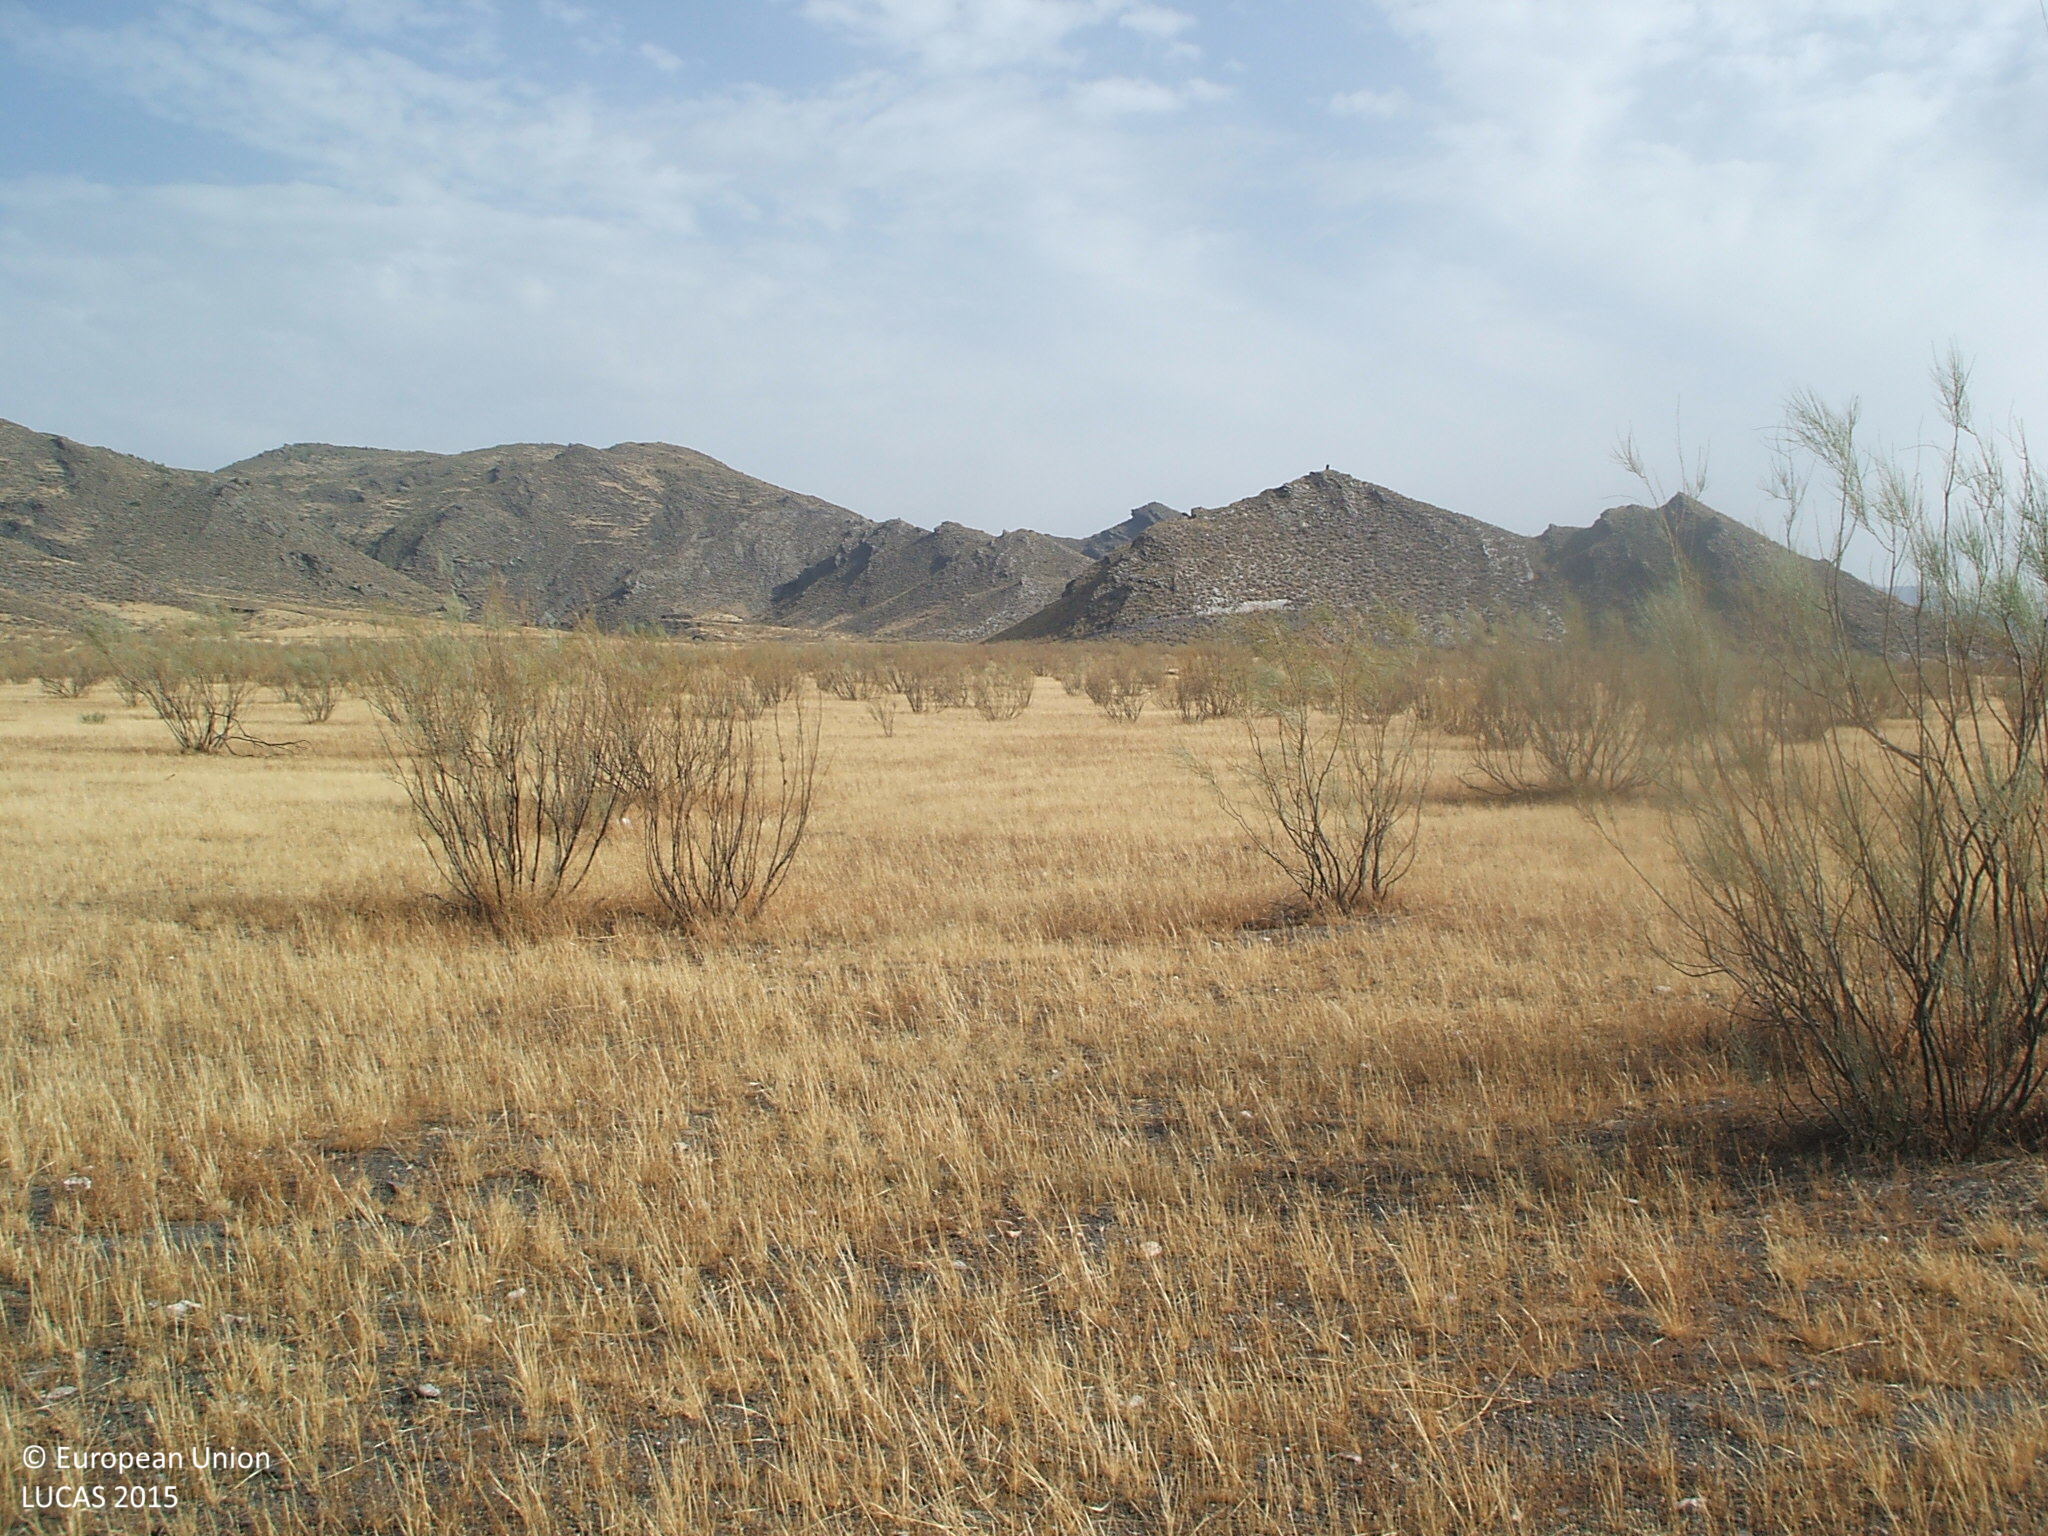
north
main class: Shrubland
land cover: Shrubland without tree cover
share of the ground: 10 - 25 %
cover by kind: herbaceous plants 85 %, shrubs 15 %
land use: Semi-natural and natural areas not in use
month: July
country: ES
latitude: 37.1227
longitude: -2.3481
